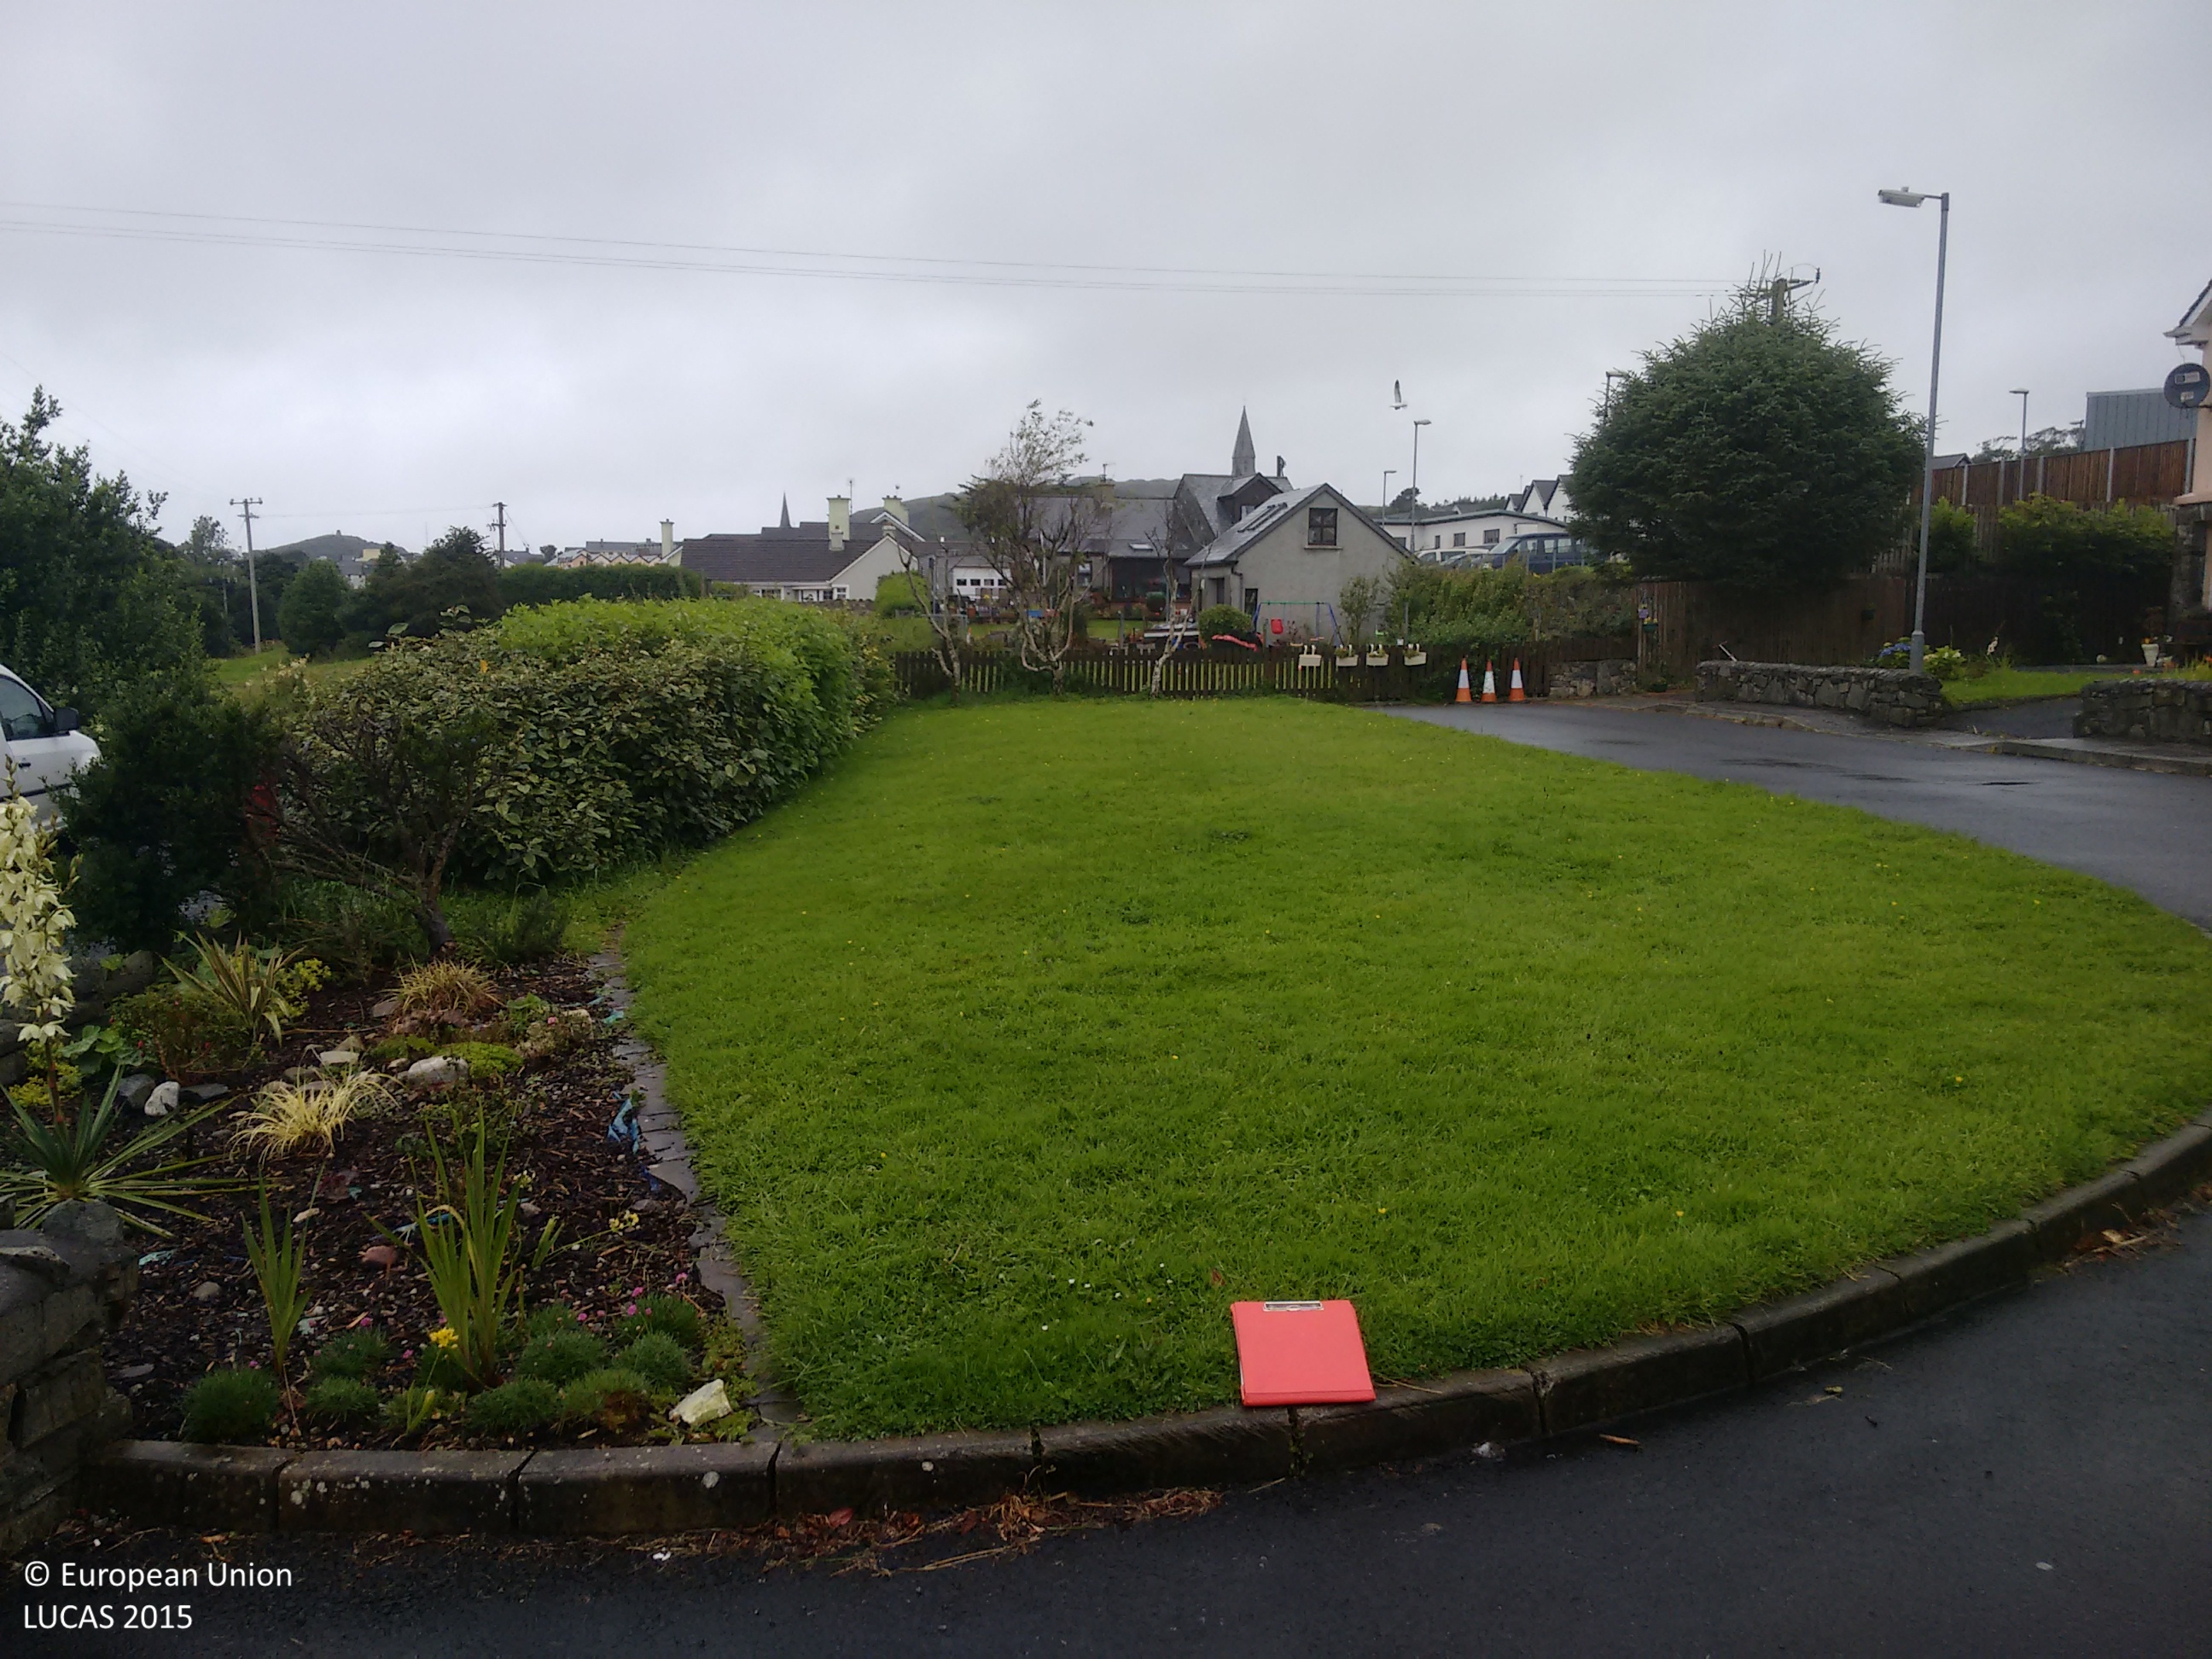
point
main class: Grassland
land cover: Grassland without tree/shrub cover
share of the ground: > 75 %
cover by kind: herbaceous plants 100 %
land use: Residential
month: July
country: IE
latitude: 53.4876
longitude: -10.0125
